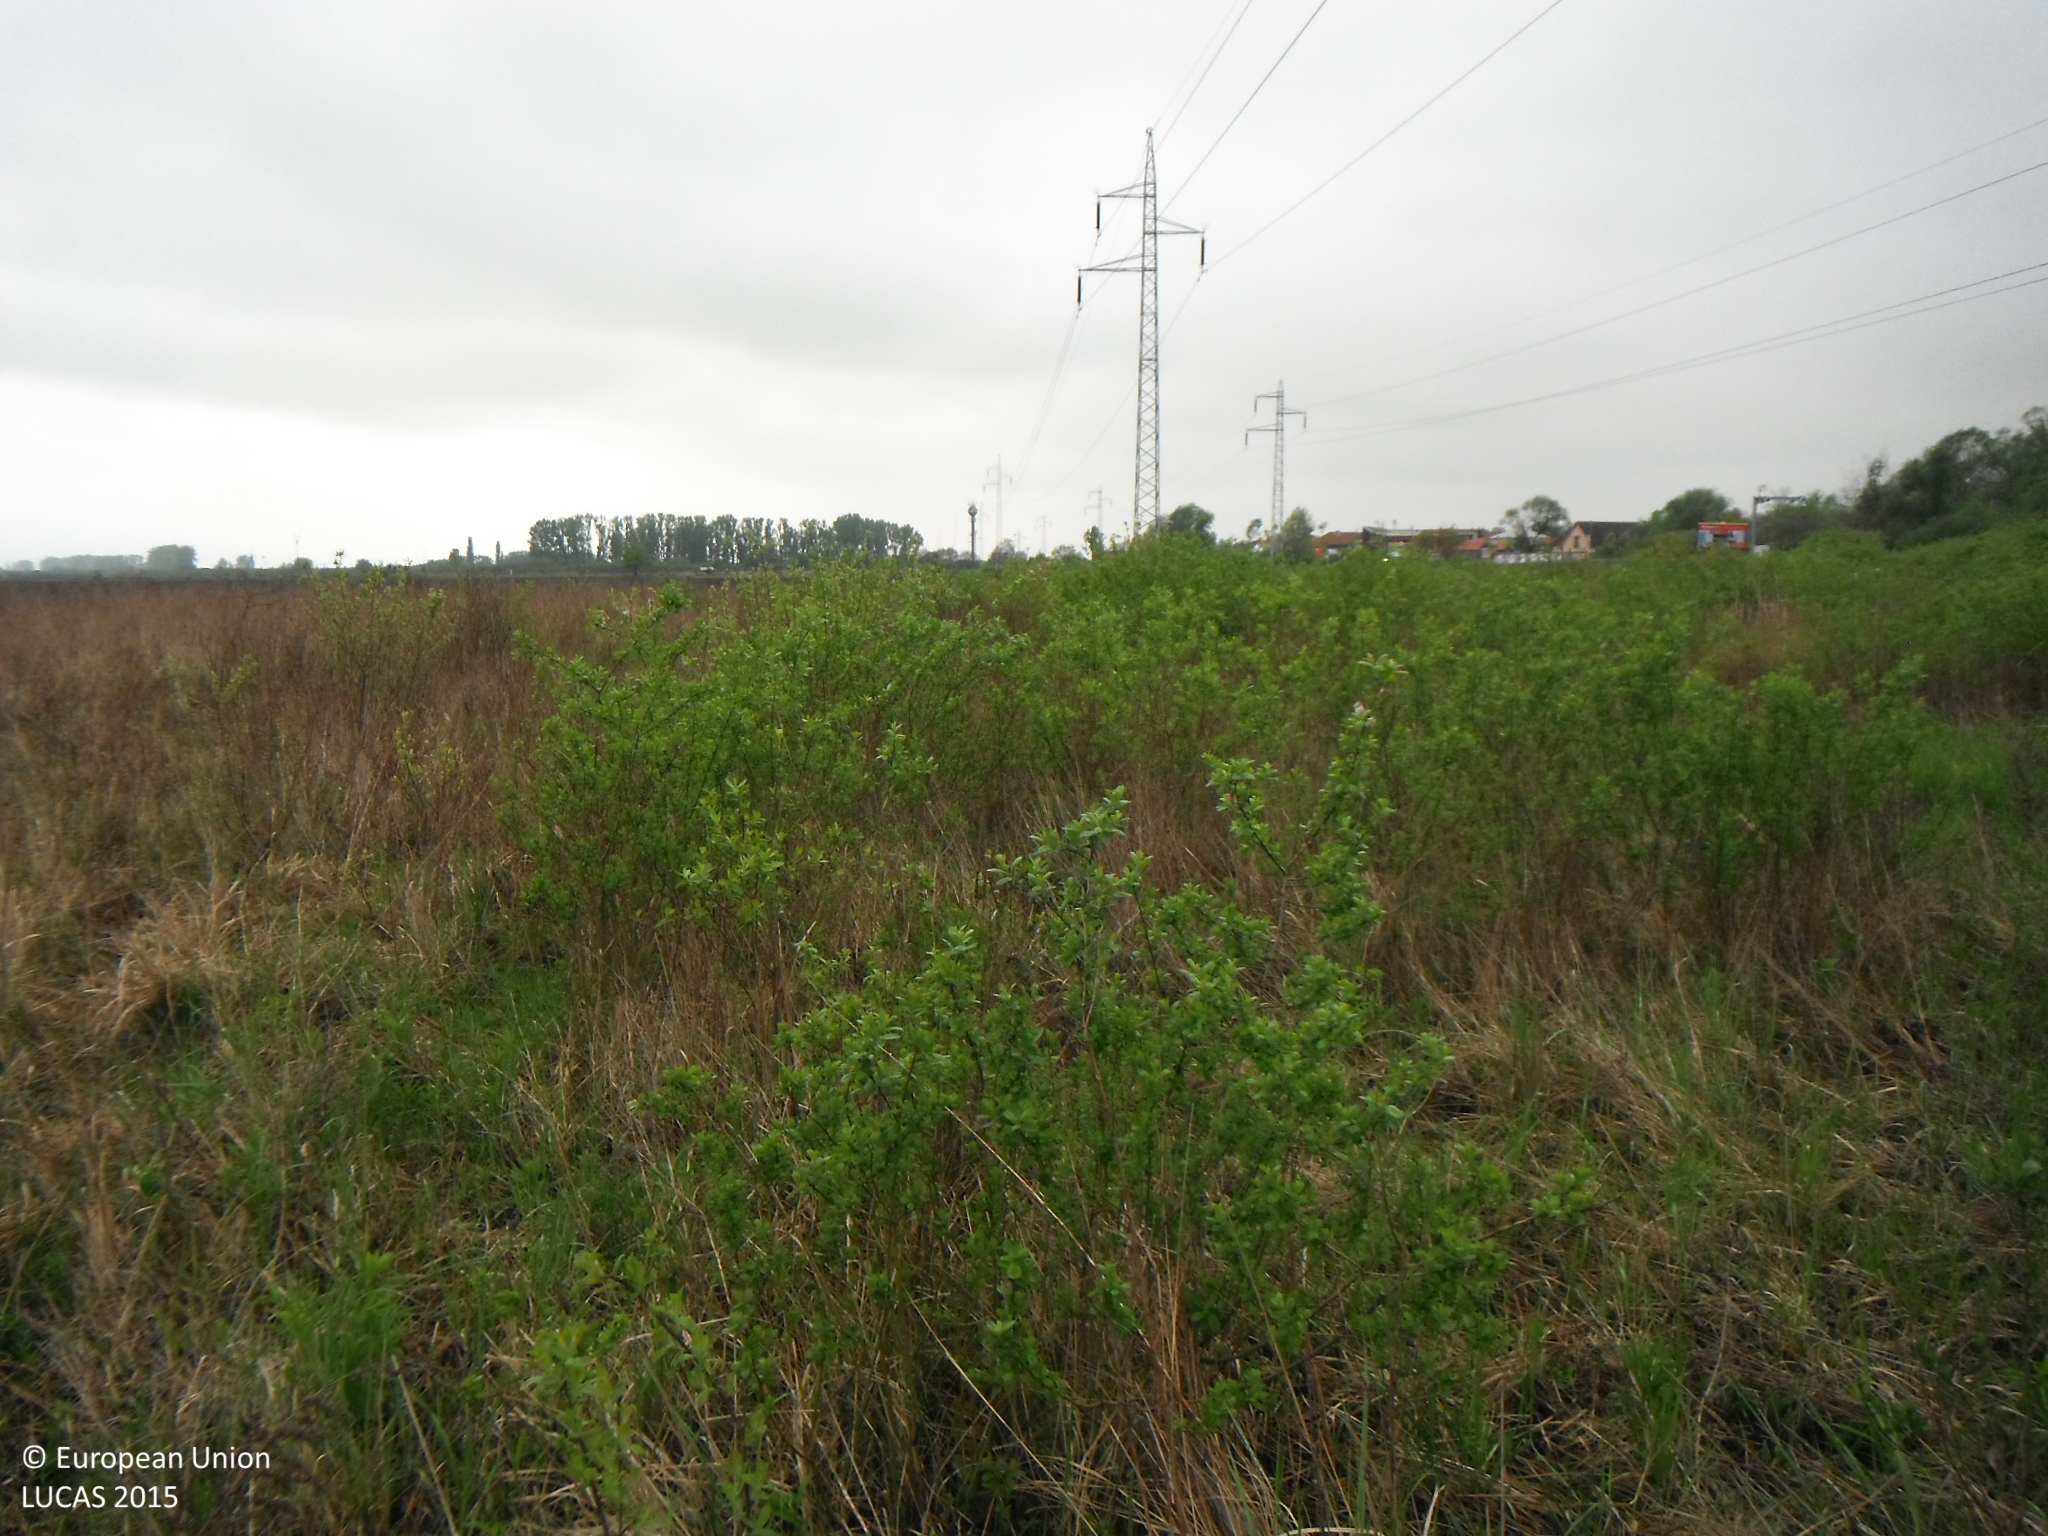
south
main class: Shrubland
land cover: Shrubland without tree cover
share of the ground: > 75 %
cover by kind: herbaceous plants 75 %, shrubs 25 %
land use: Abandoned areas
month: May
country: SK
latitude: 48.6606
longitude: 21.2725
